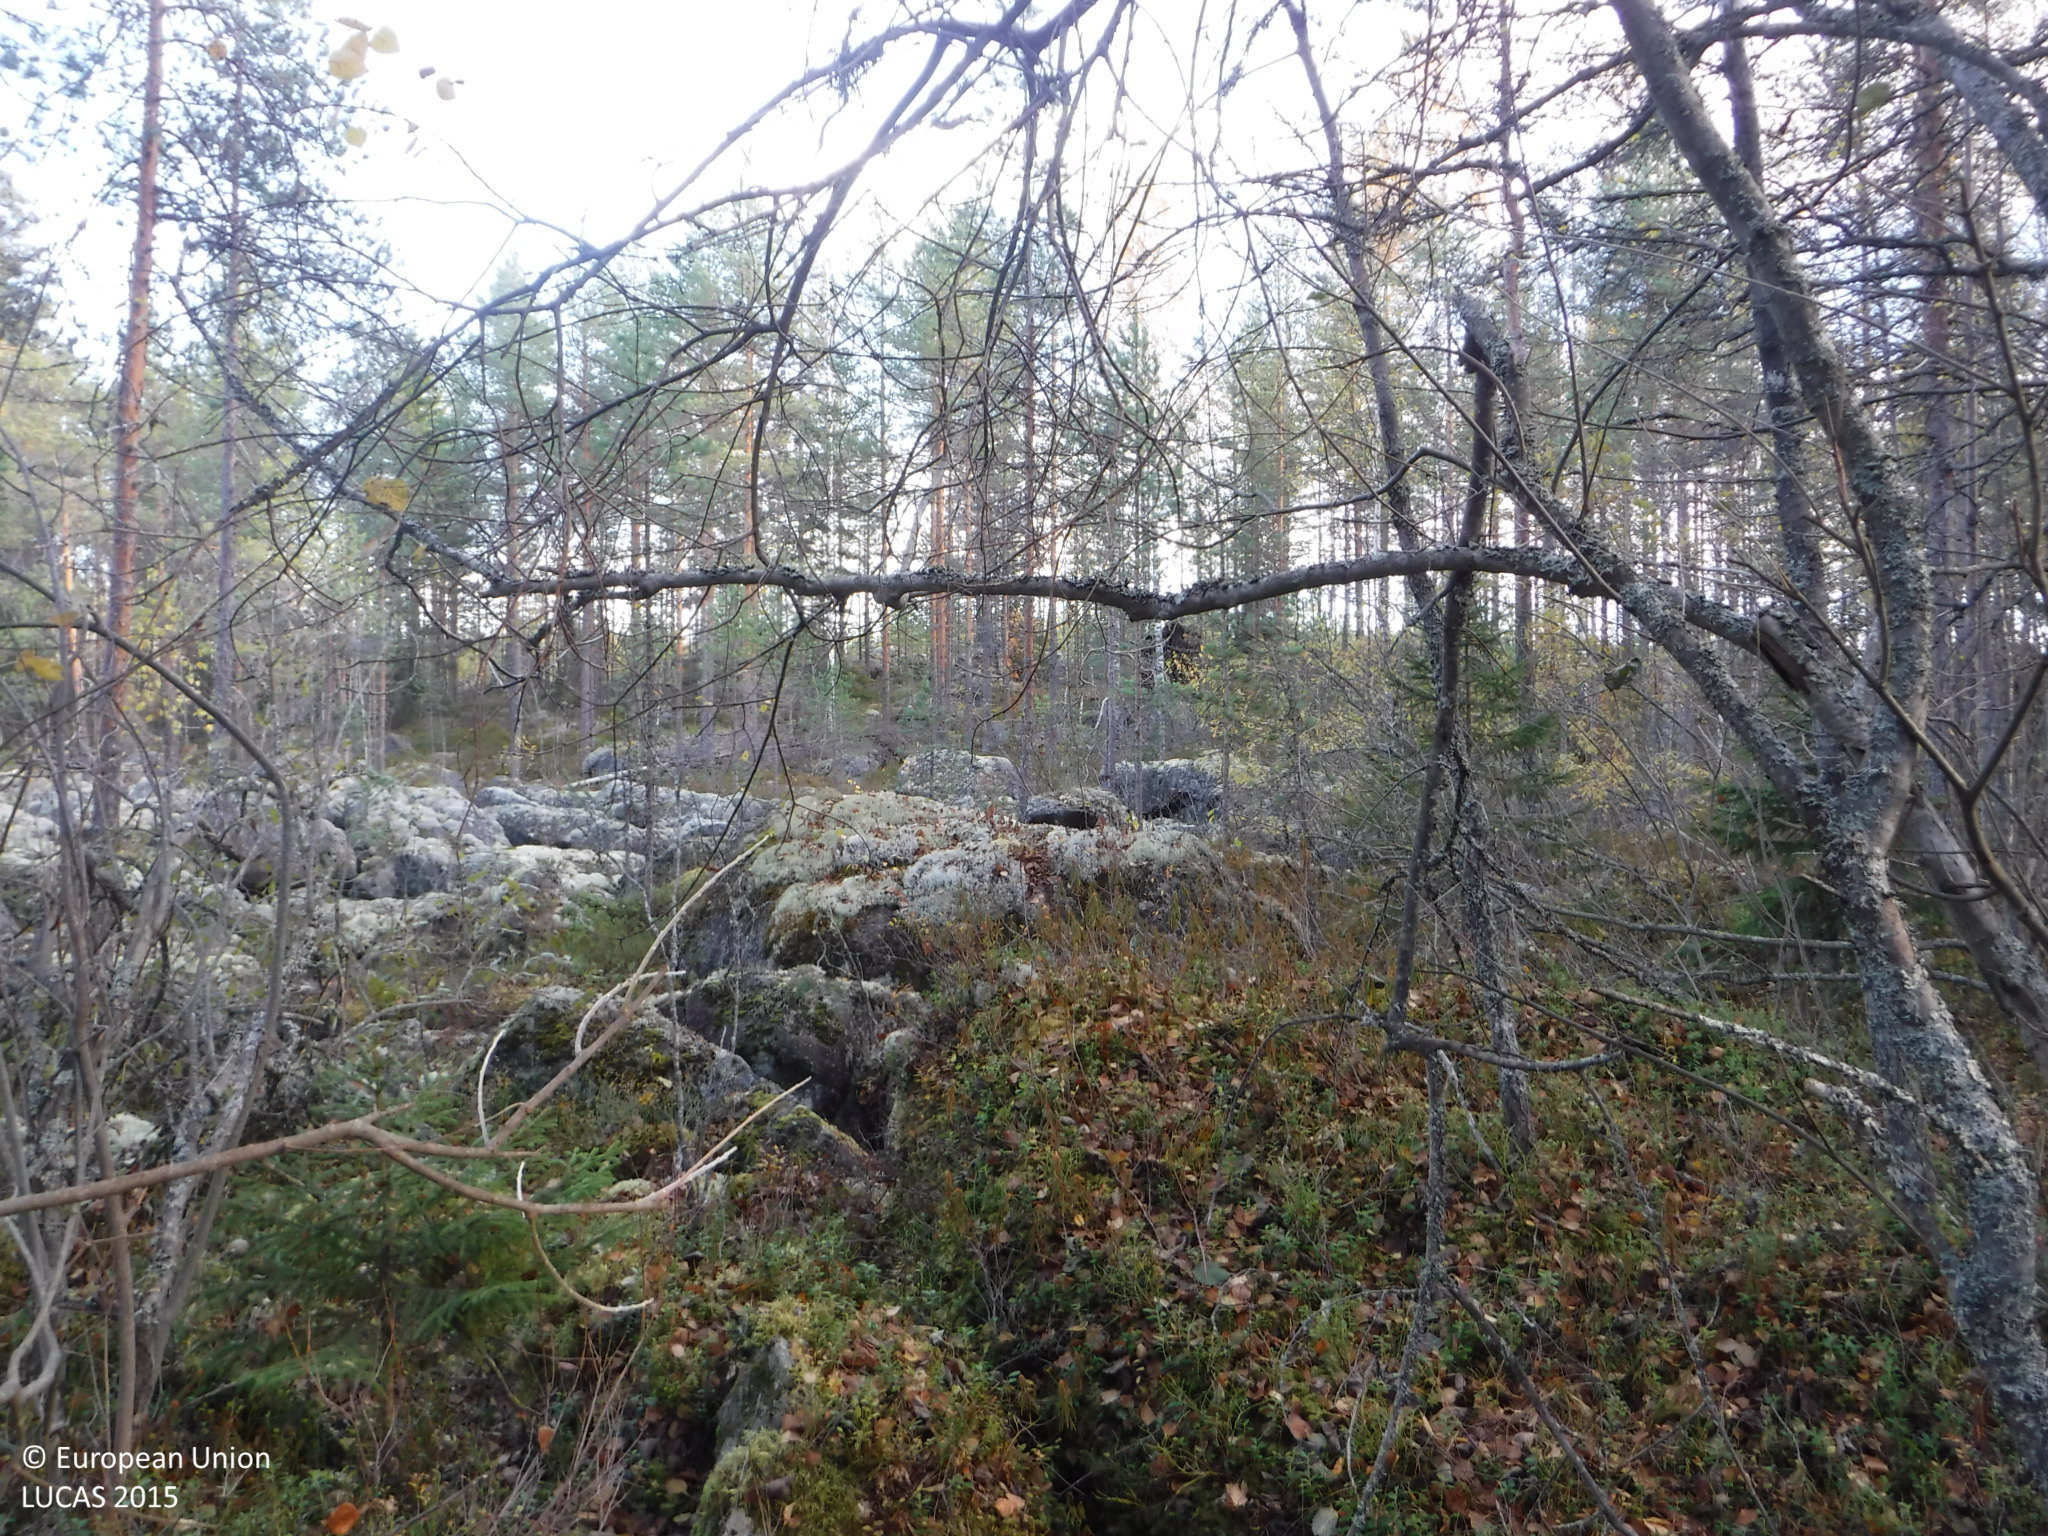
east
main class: Woodland
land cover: Pine dominated mixed woodland
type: boreal forest
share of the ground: 50 - 75 %
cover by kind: coniferous forest trees 30 %, broadleaved forest trees 30 %, shrubs 20 %, lichens and mosses 20 %
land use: Forestry
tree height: > 5 m
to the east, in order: Pine dominated mixed woodland; Lichens and moss; Pine dominated mixed woodland; Paved roads, cycling and walking lanes; Pine dominated coniferous woodland; Ditches and canals; Pine dominated coniferous woodland
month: October
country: FI
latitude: 62.0067
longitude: 25.9995
